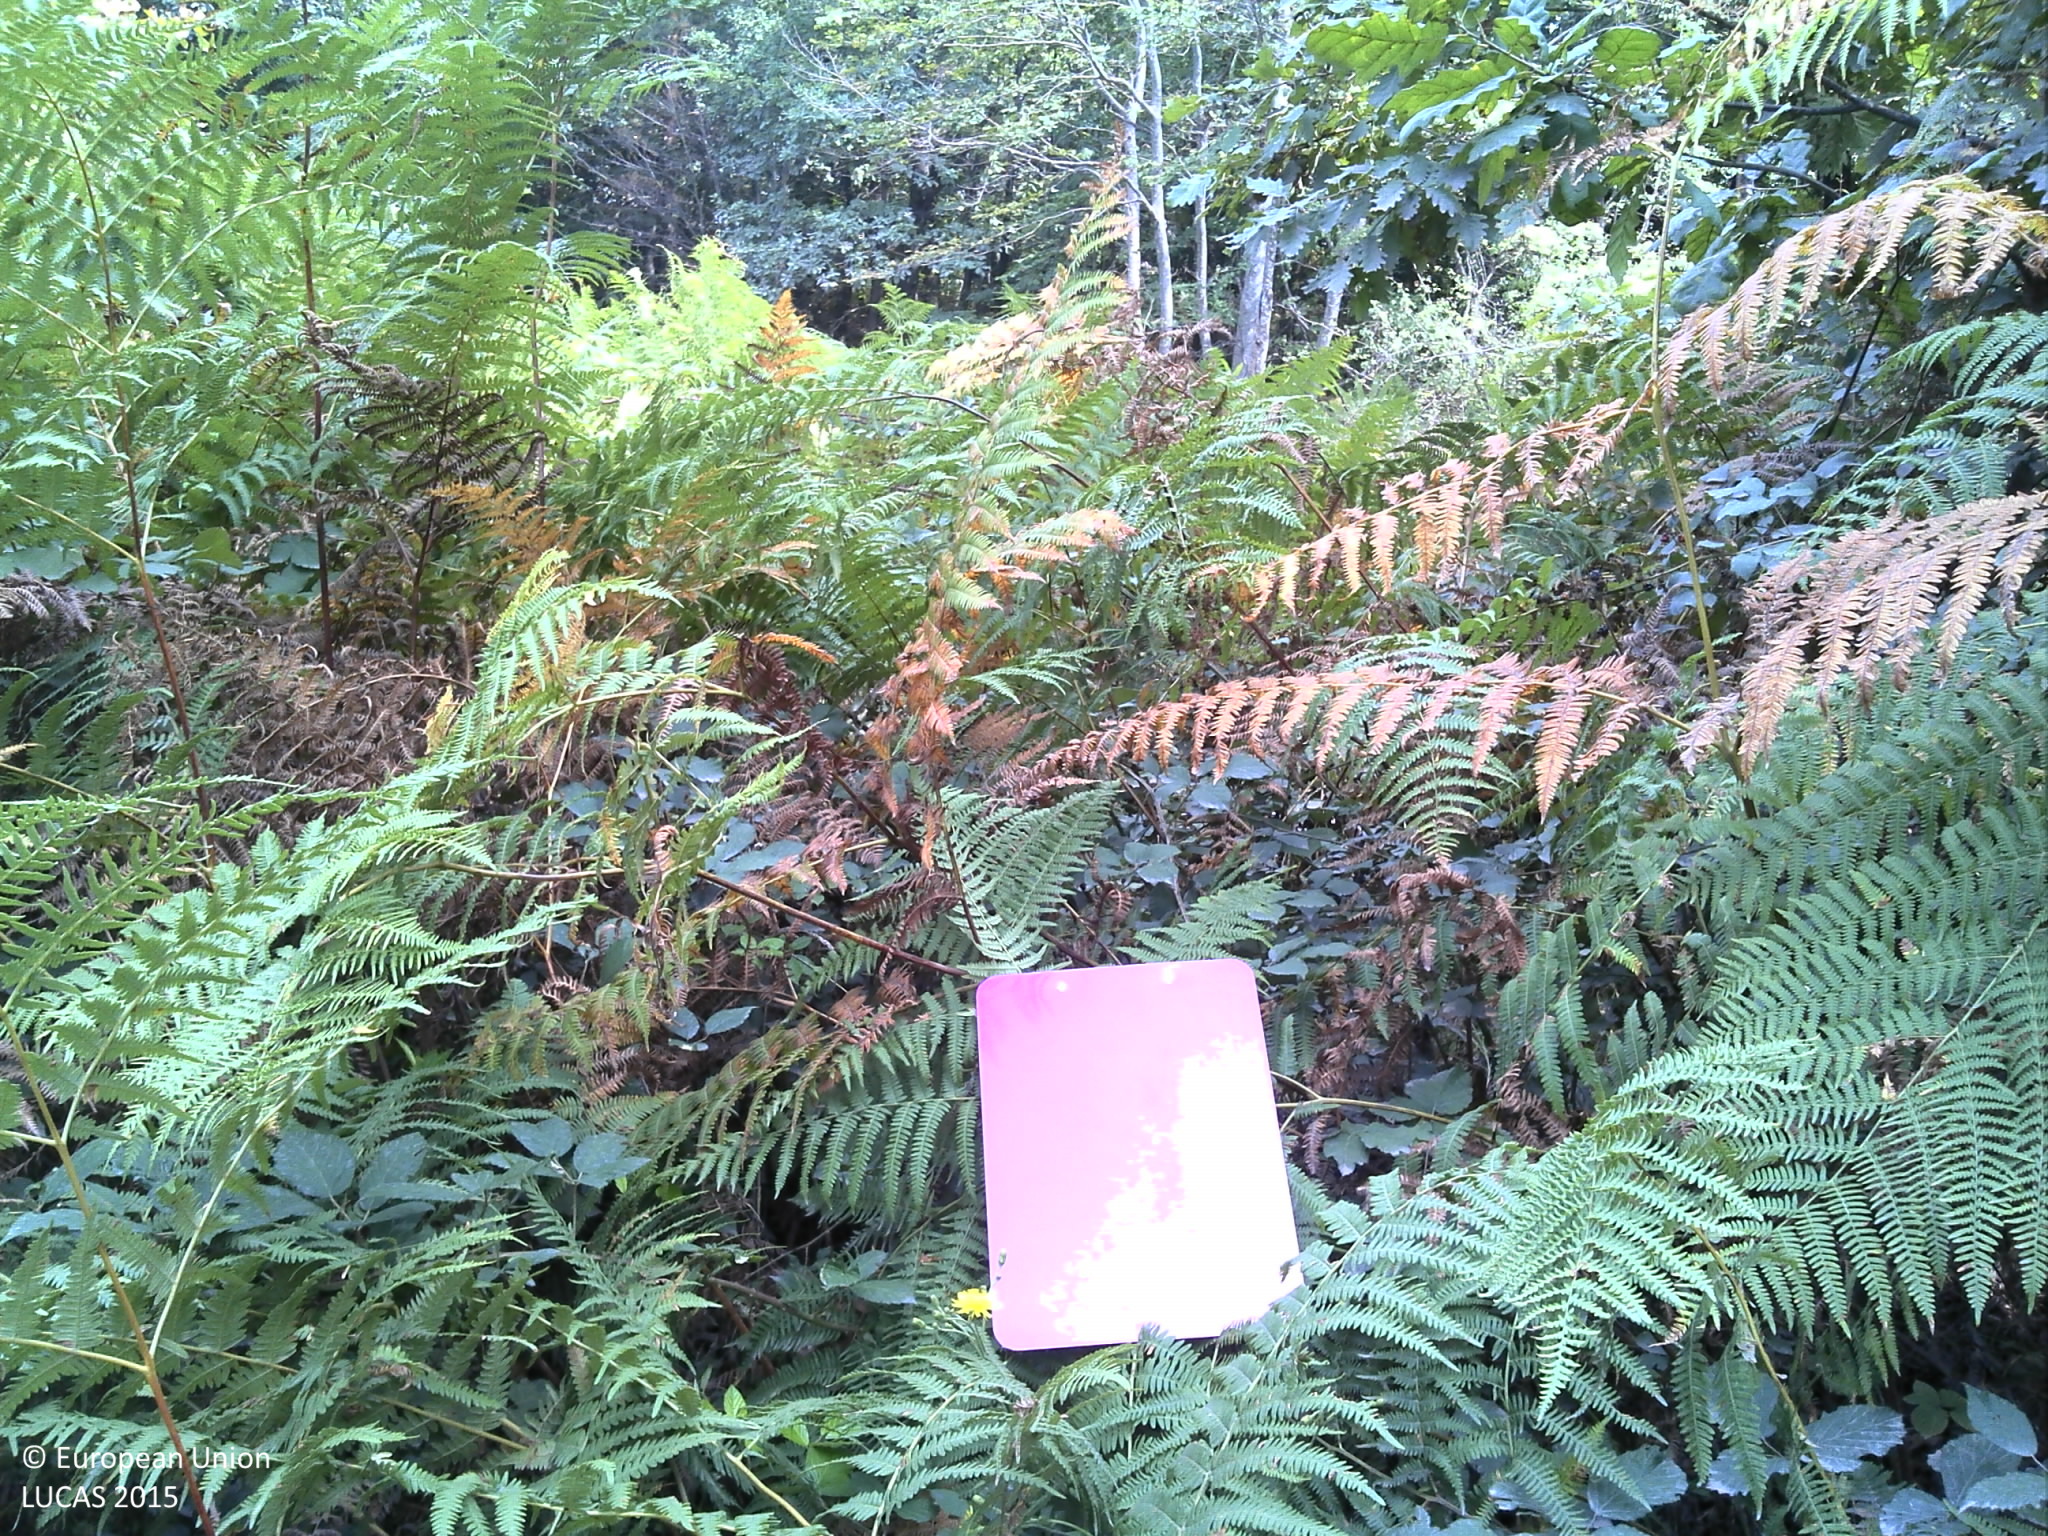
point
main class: Shrubland
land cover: Shrubland with sparse tree cover
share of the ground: > 75 %
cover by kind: shrubs 95 %, broadleaved forest trees 5 %
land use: Forestry
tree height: < 5 m
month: August
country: HR
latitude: 45.2227
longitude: 16.0456
